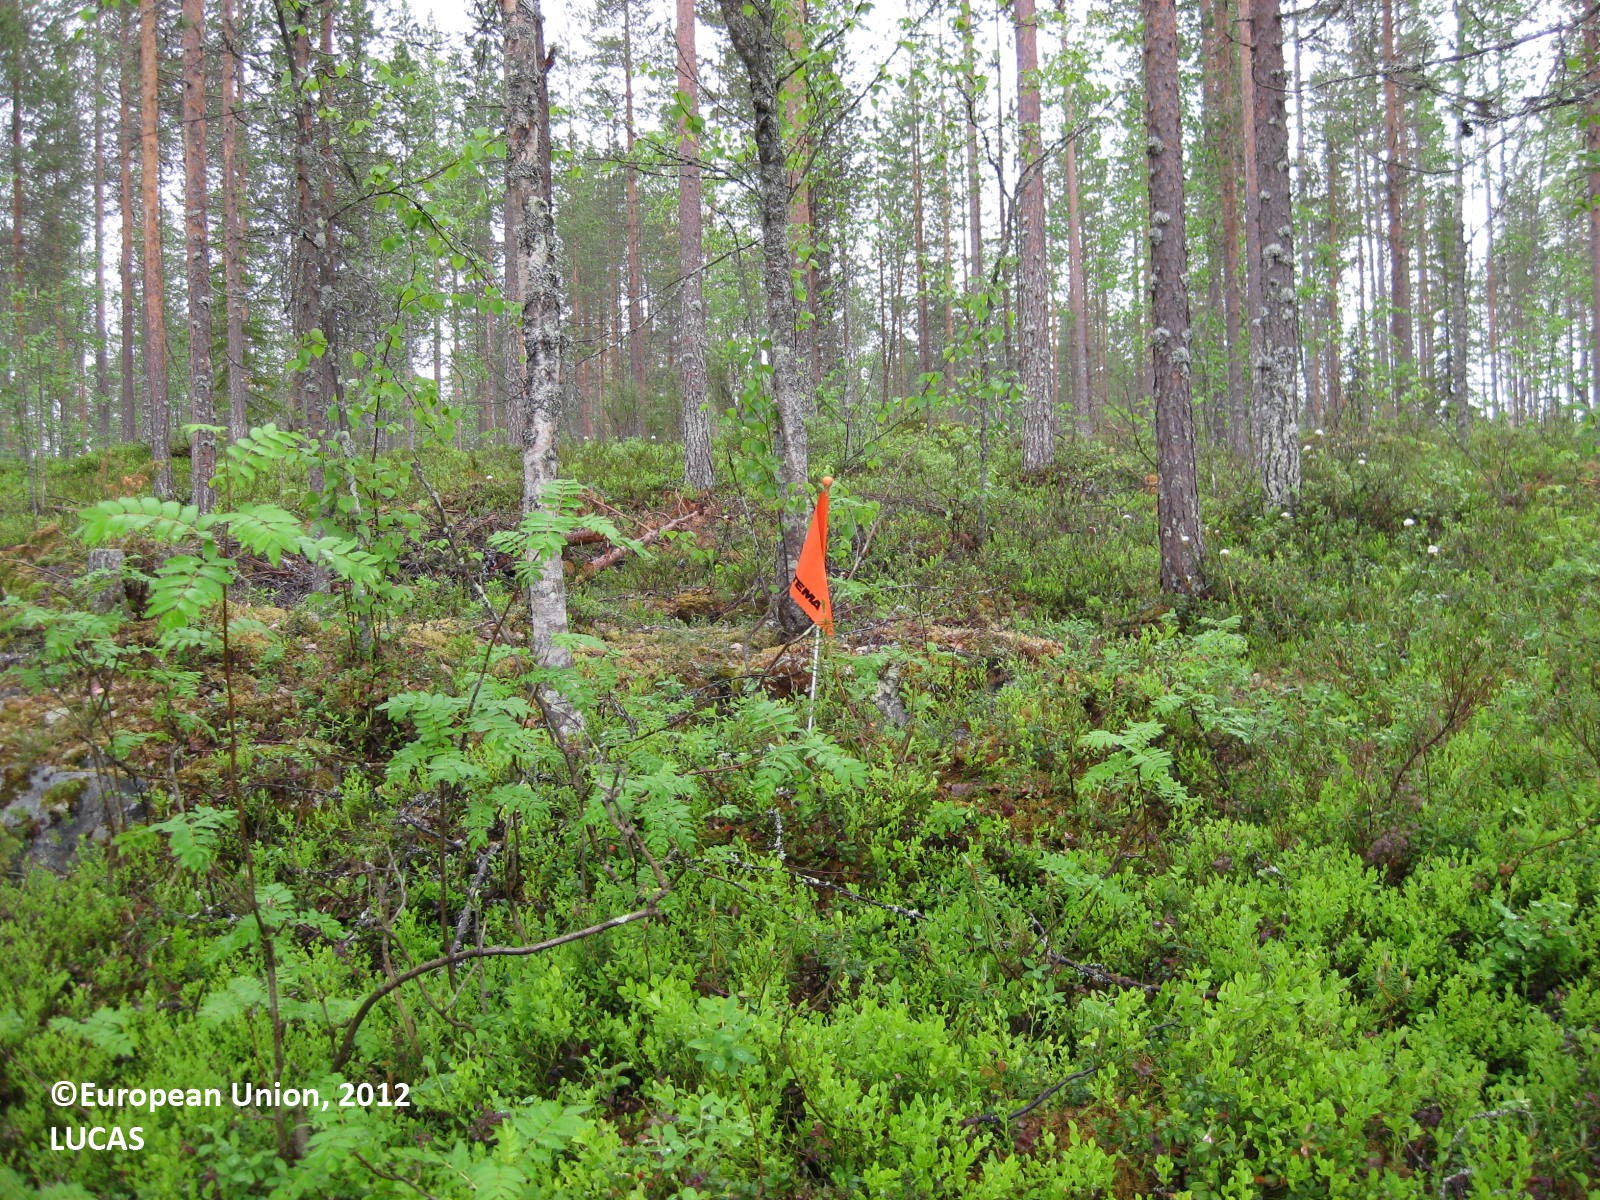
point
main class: Woodland
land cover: Pine dominated mixed woodland
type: boreal forest
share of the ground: 50 - 75 %
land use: Forestry
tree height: > 5 m
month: June
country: FI
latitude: 65.1454
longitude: 29.2790
